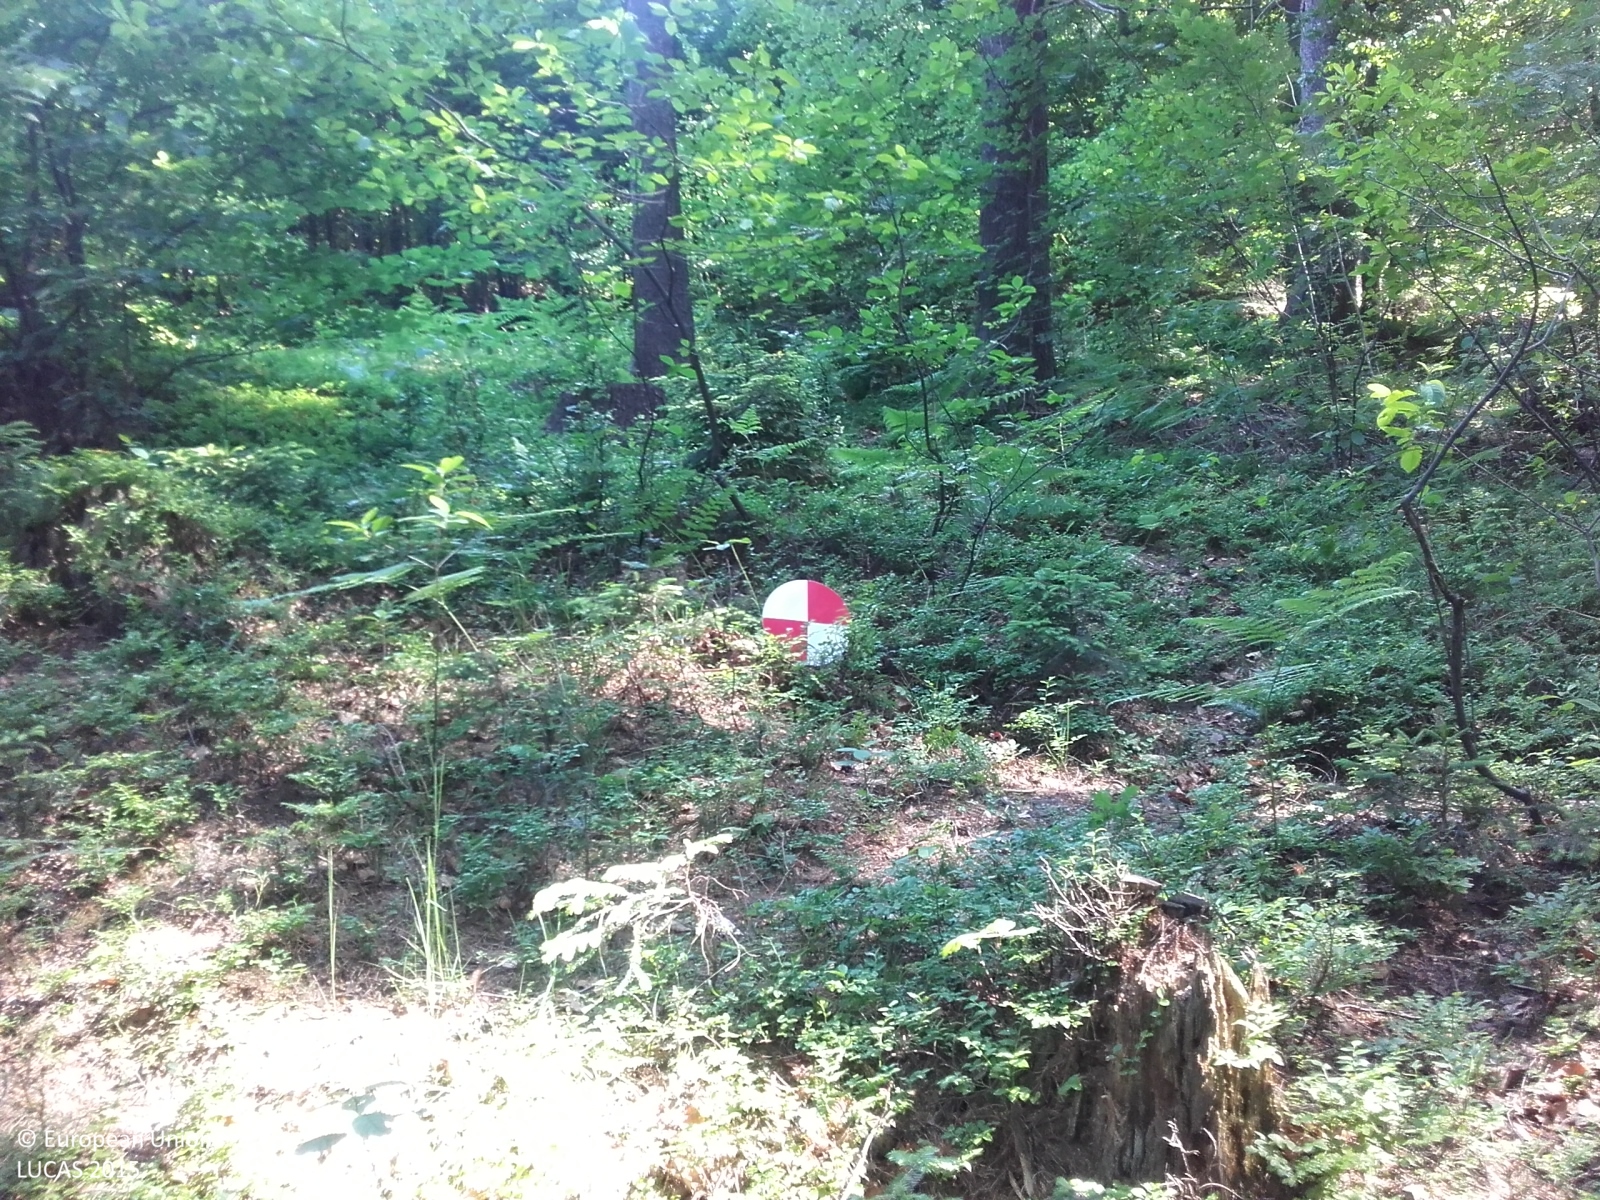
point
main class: Woodland
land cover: Spruce dominated mixed woodland
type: hemiboreal forest and nemoral coniferous forest and mixed broadleaved-coniferous forest
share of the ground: > 75 %
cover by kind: coniferous forest trees 60 %, broadleaved forest trees 30 %, herbaceous plants 10 %
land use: Forestry
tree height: > 5 m
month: June
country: CZ
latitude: 49.6119
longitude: 18.7533
